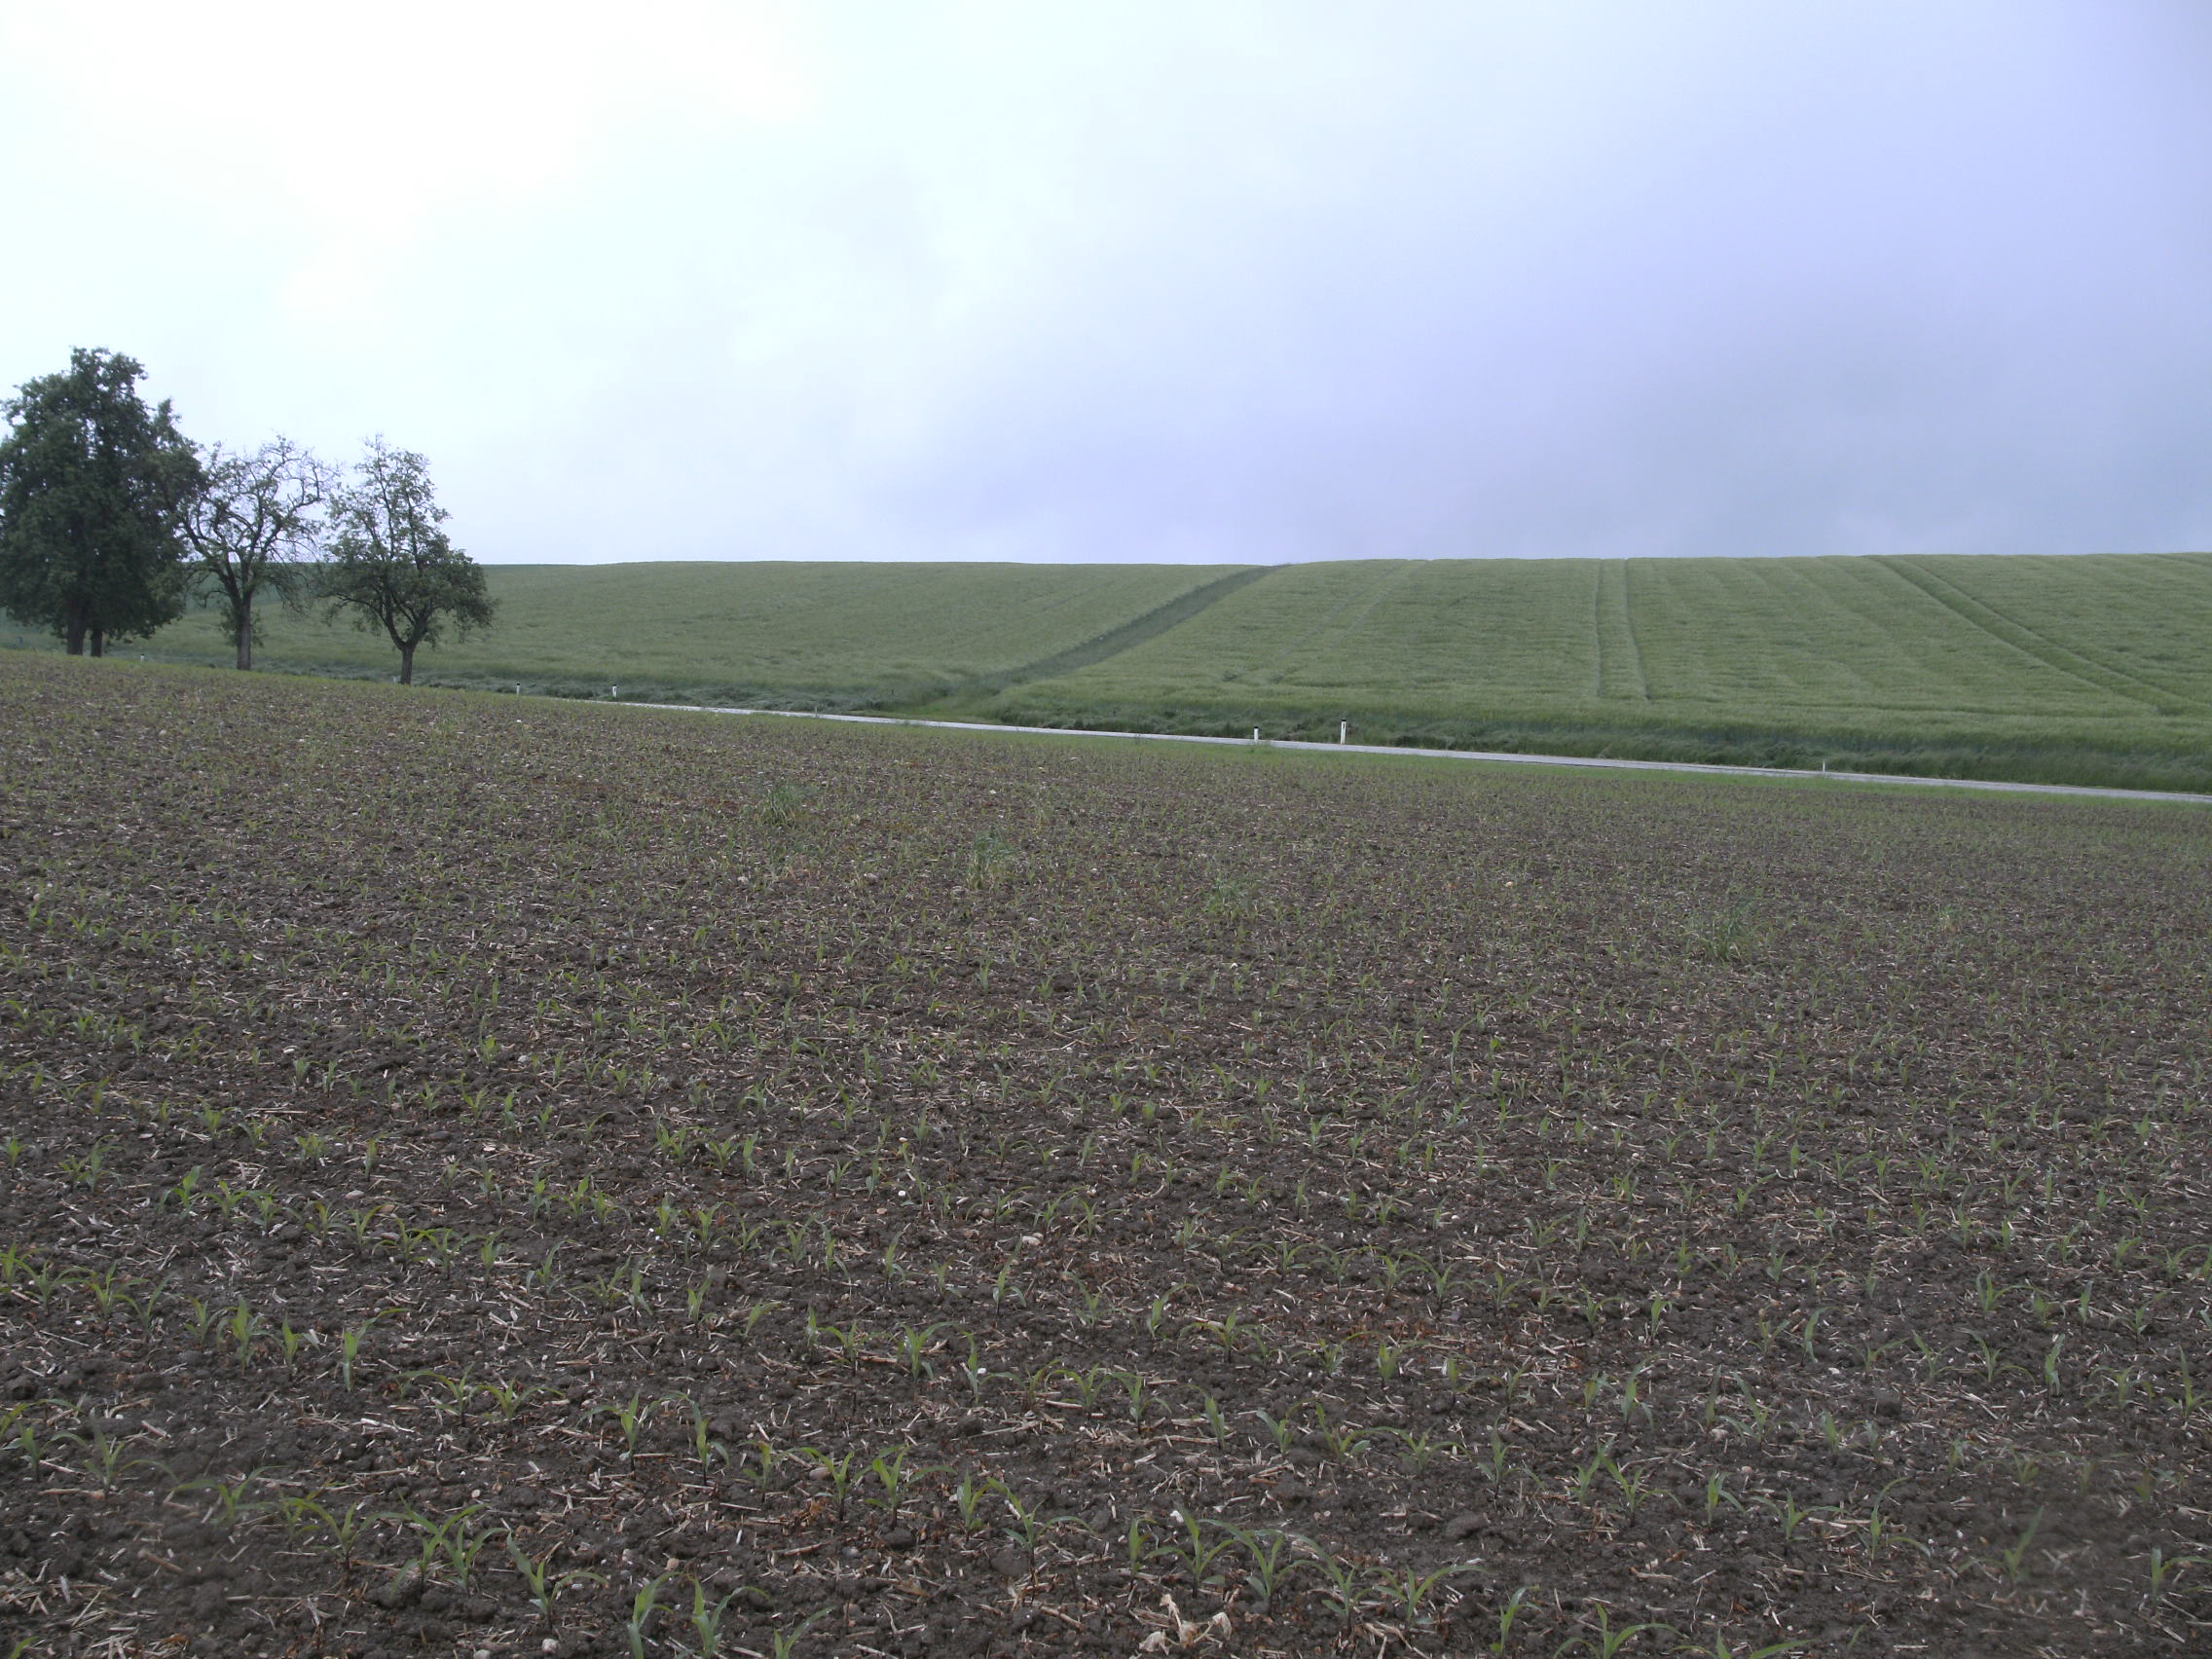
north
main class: Cropland
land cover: Maize
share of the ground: < 10 %
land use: Agriculture (excluding fallow land and kitchen gardens)
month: May
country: AT
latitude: 48.3413
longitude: 13.7098
